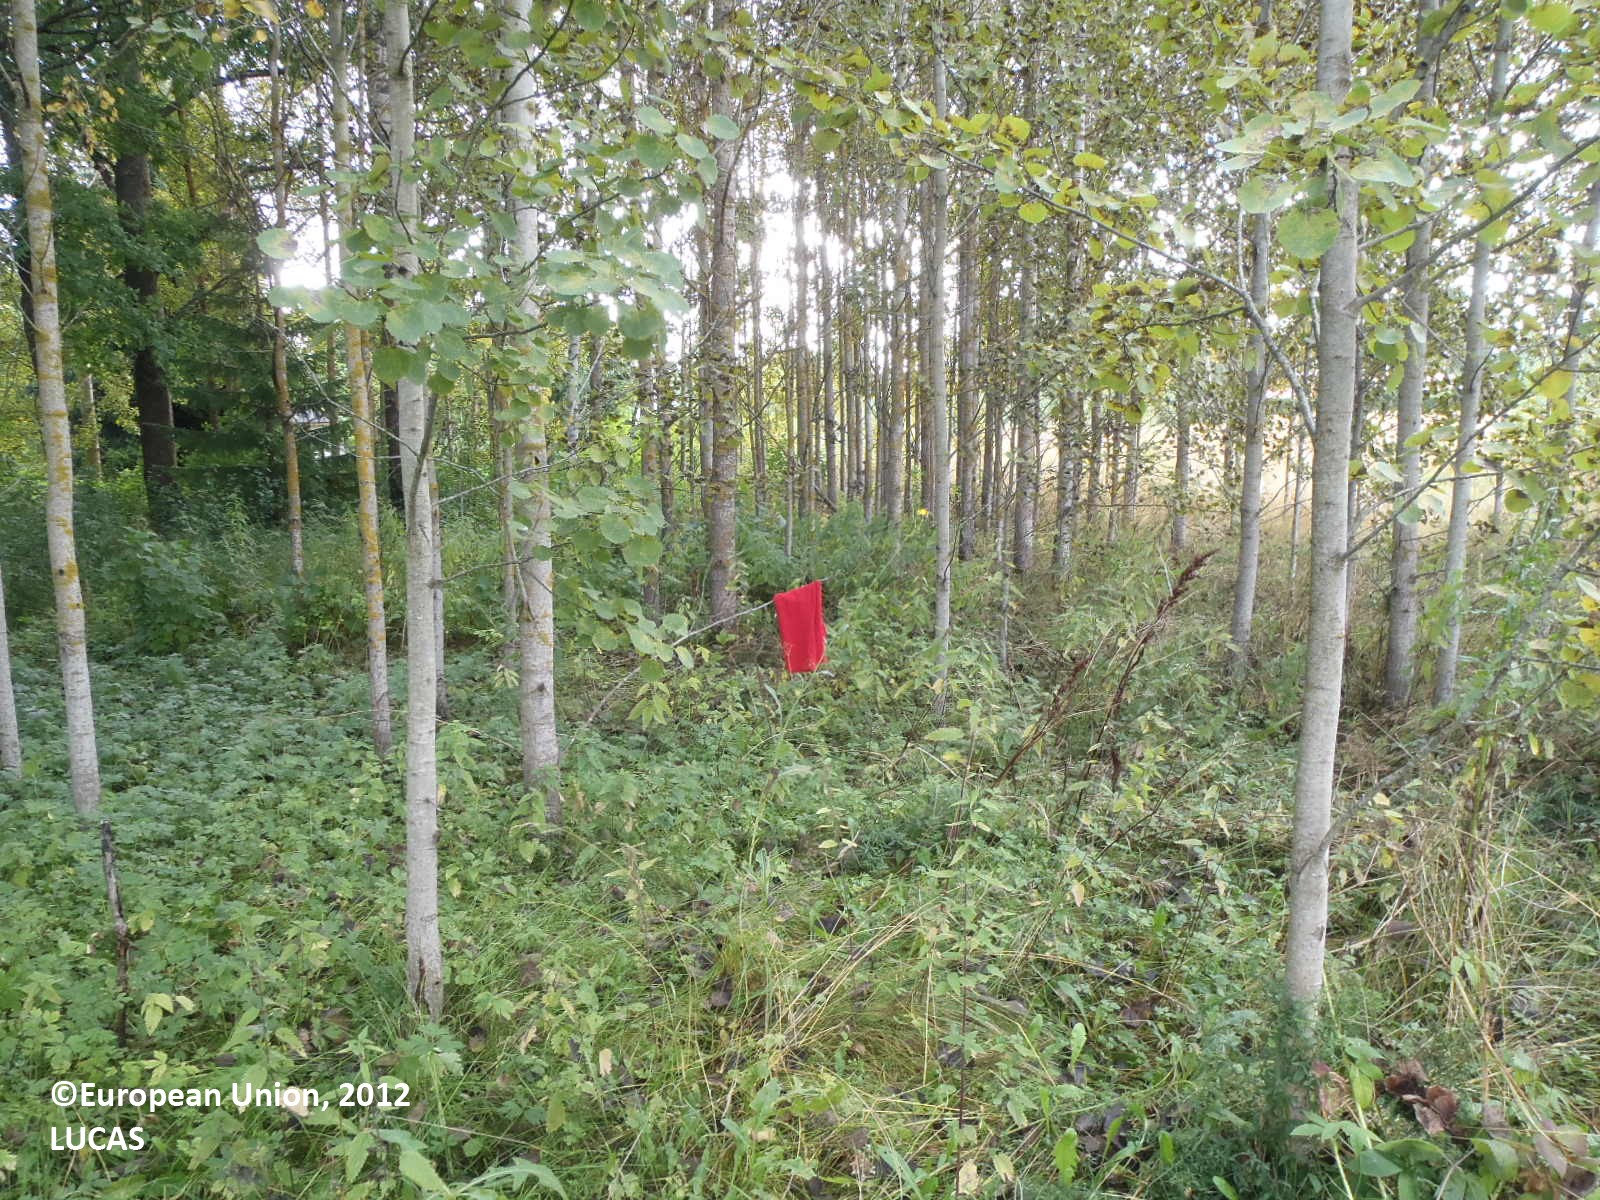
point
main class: Woodland
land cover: Broadleaved woodland
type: boreal forest
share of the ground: > 75 %
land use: Residential
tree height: > 5 m
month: September
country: FI
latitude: 61.2852
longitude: 22.6996
